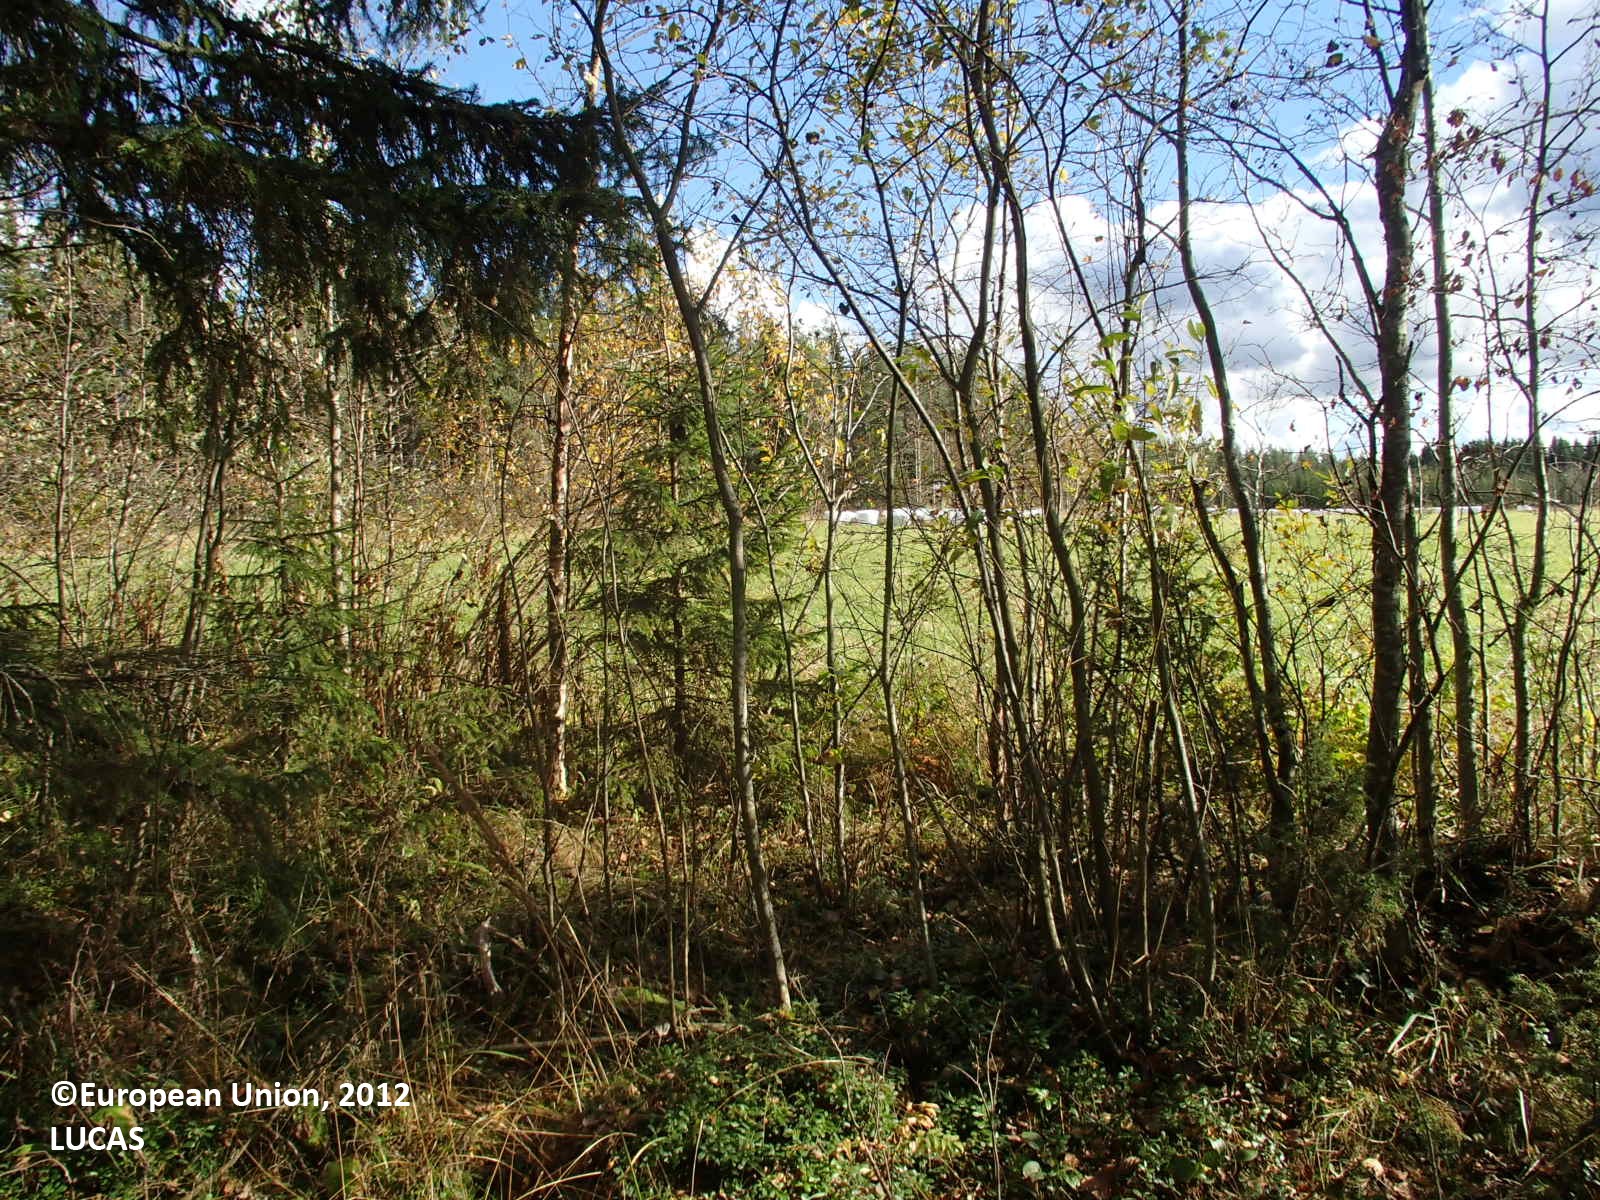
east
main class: Woodland
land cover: Spruce dominated mixed woodland
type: boreal forest
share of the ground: > 75 %
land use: Forestry
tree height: > 5 m
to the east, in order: Spruce dominated mixed woodland; Ditches and canals; Temporary grasslands; Ditches and canals; Other mixed woodland
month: September
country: FI
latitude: 63.6200
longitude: 26.6506
